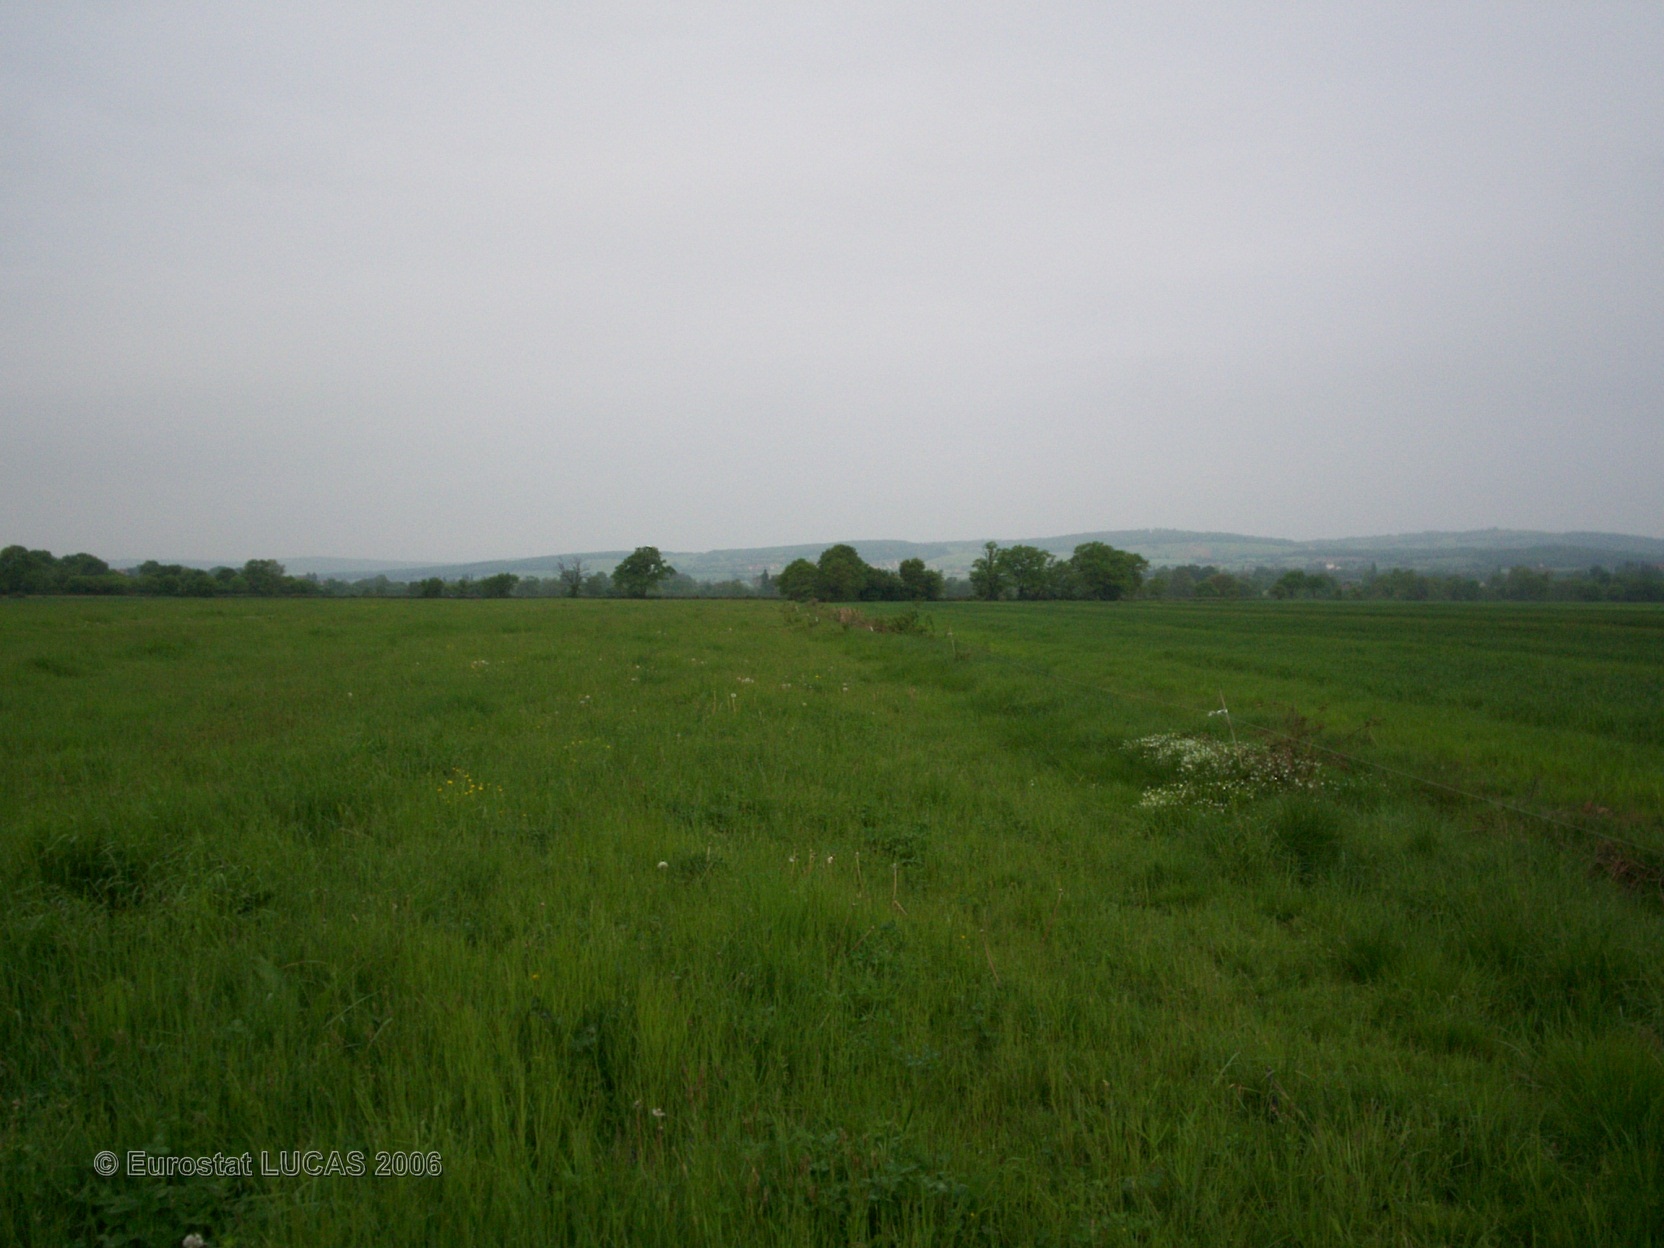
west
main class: Grassland
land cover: Grassland without tree/shrub cover
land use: Agriculture (excluding fallow land and kitchen gardens)
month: May
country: FR
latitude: 46.5431
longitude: 4.6679
